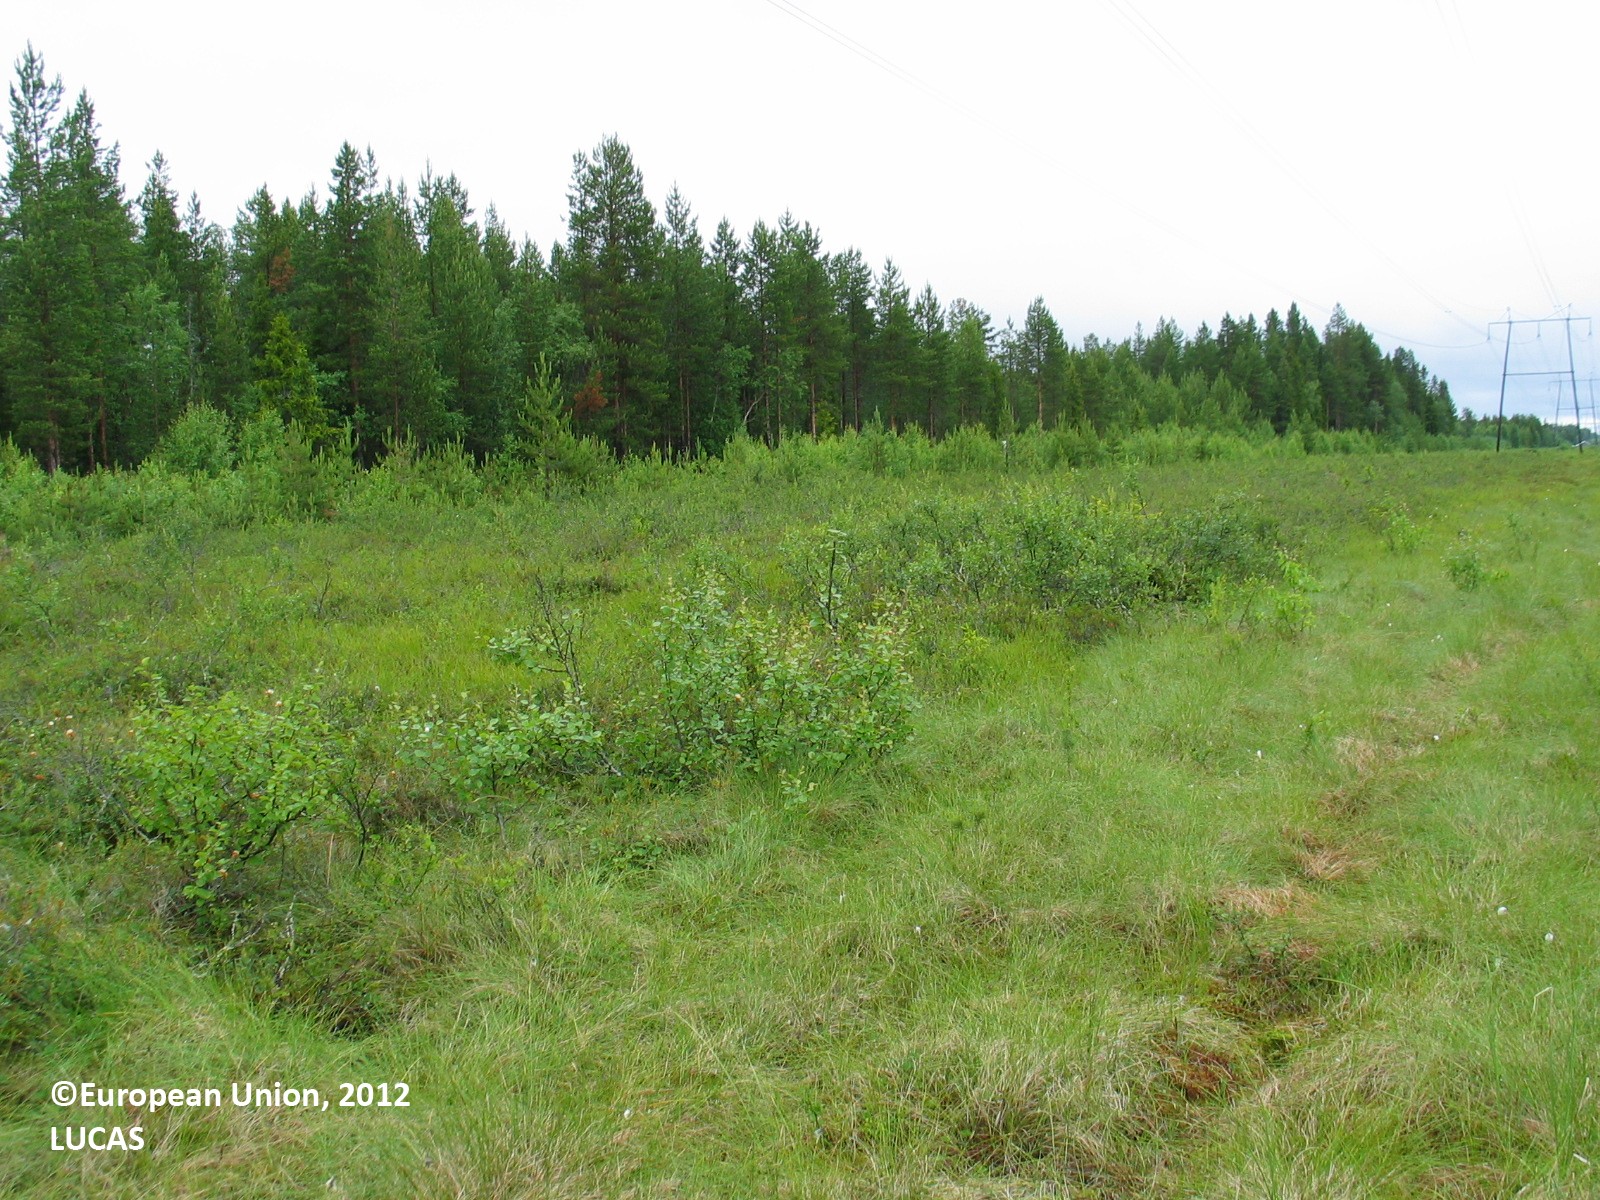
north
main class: Grassland
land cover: Grassland without tree/shrub cover
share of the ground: > 75 %
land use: Energy production
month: July
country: FI
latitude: 66.0444
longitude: 25.0025
